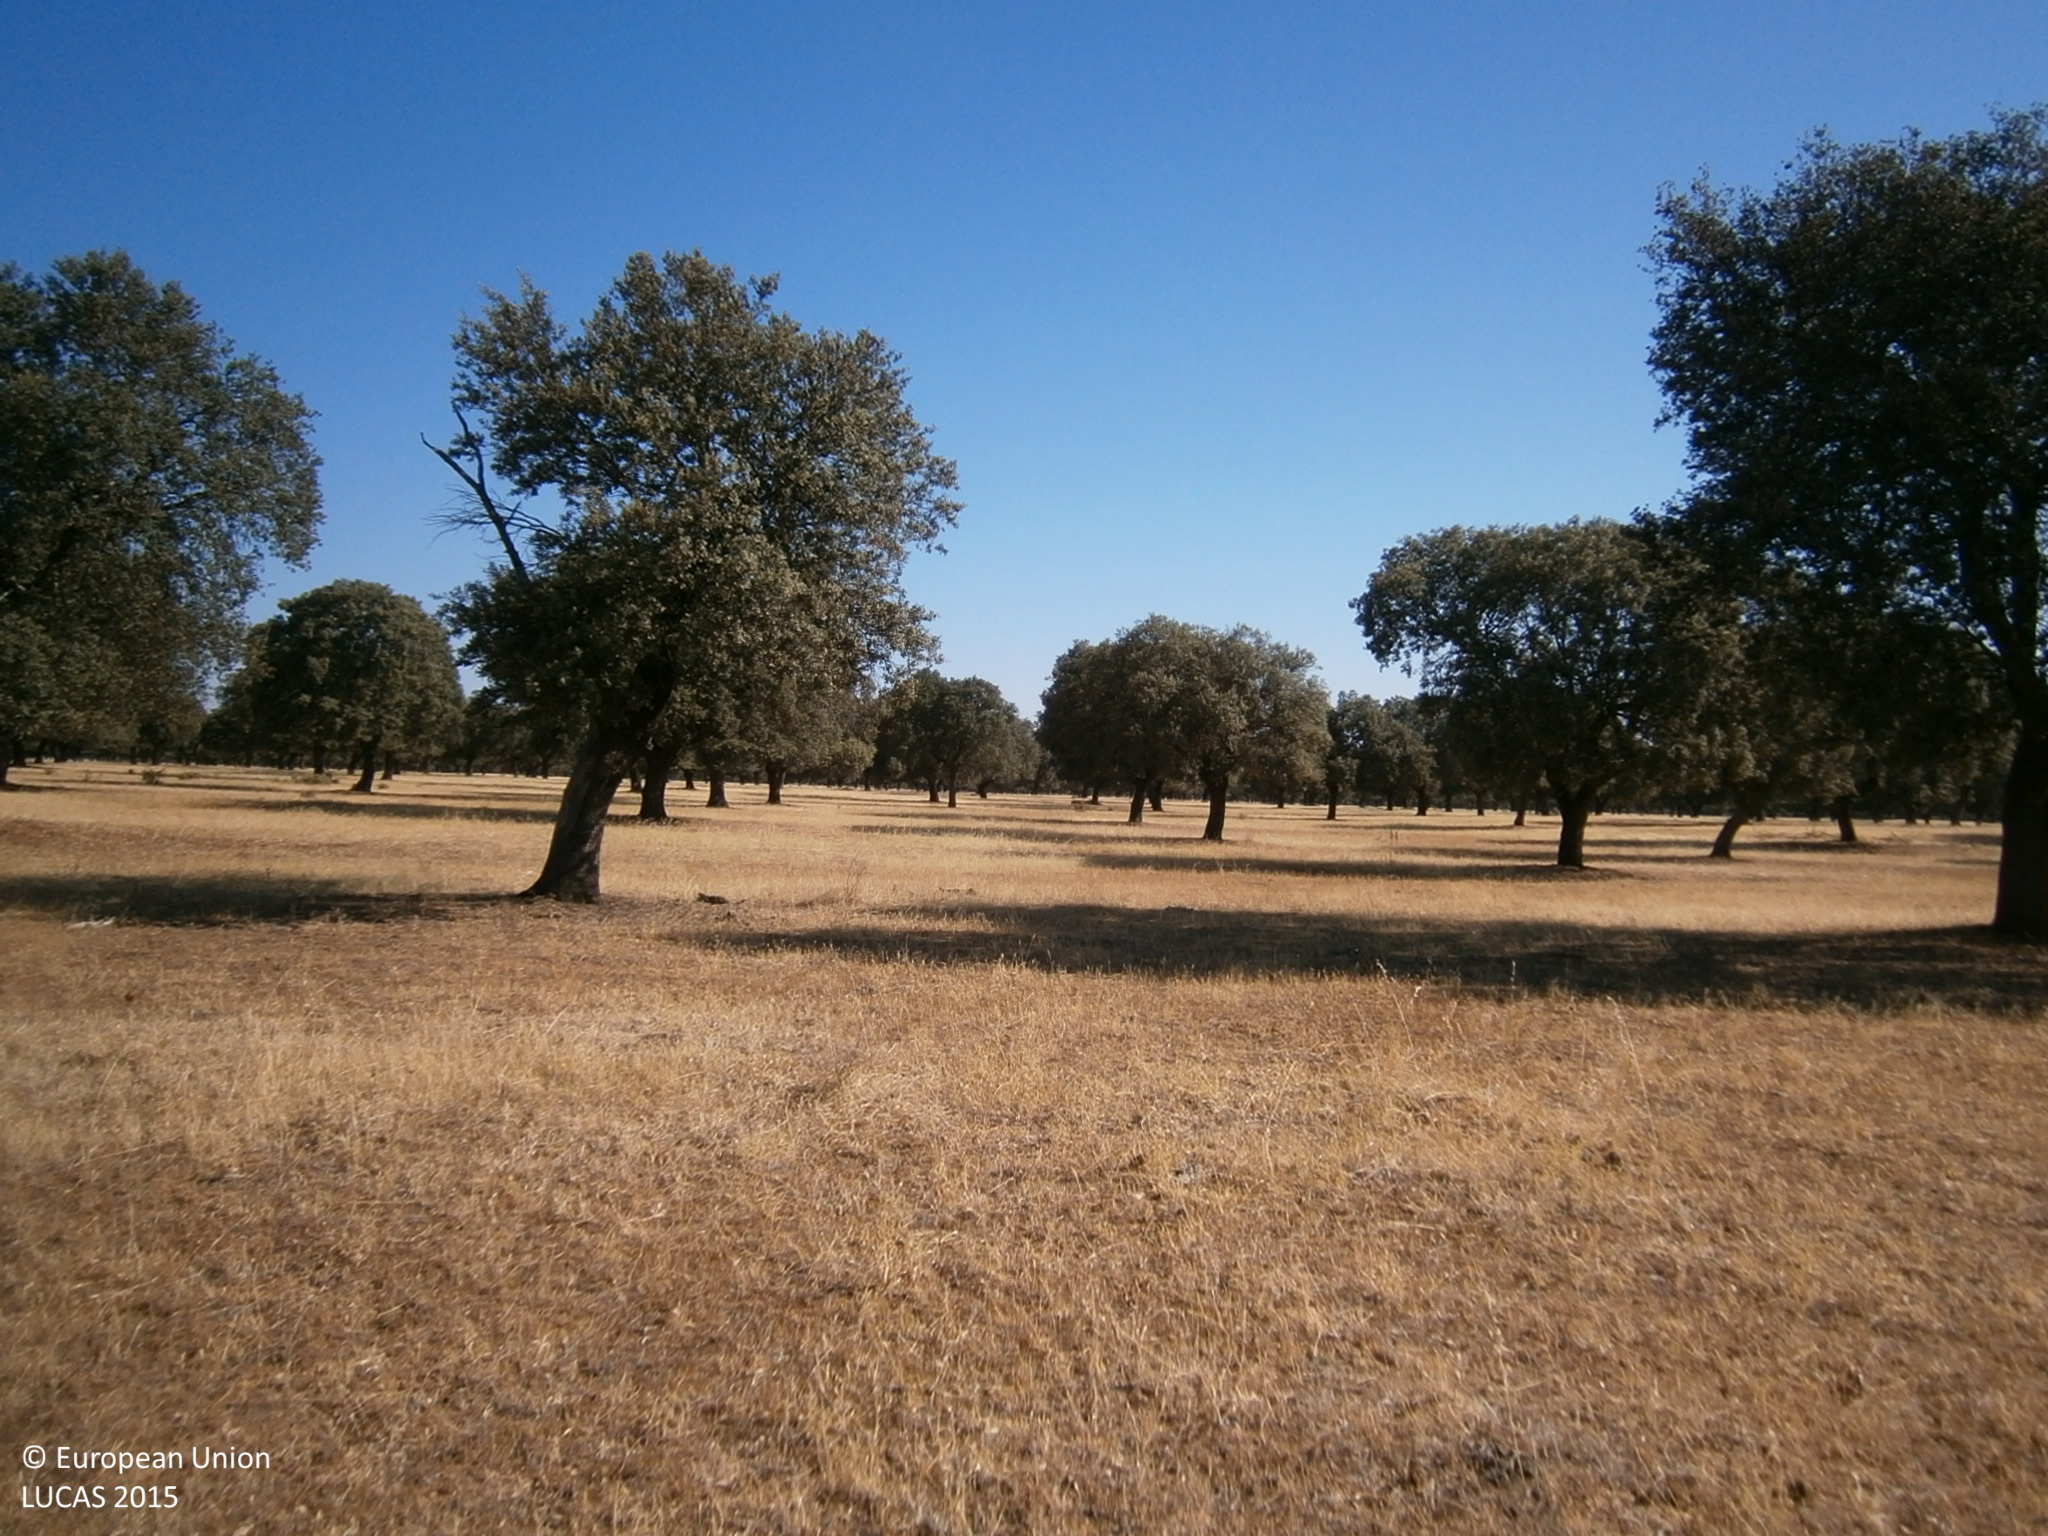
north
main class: Woodland
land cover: Broadleaved woodland
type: broadleaved evergreen forest
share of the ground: 25 - 50 %
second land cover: Spontaneously vegetated surfaces
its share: 50 - 75 %
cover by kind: broadleaved forest trees 40 %, herbaceous plants 40 %, unconsolidated bare surface 20 %
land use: Forestry
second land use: Agriculture (excluding fallow land and kitchen gardens)
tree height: > 5 m
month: July
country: ES
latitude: 38.9741
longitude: -6.7929
